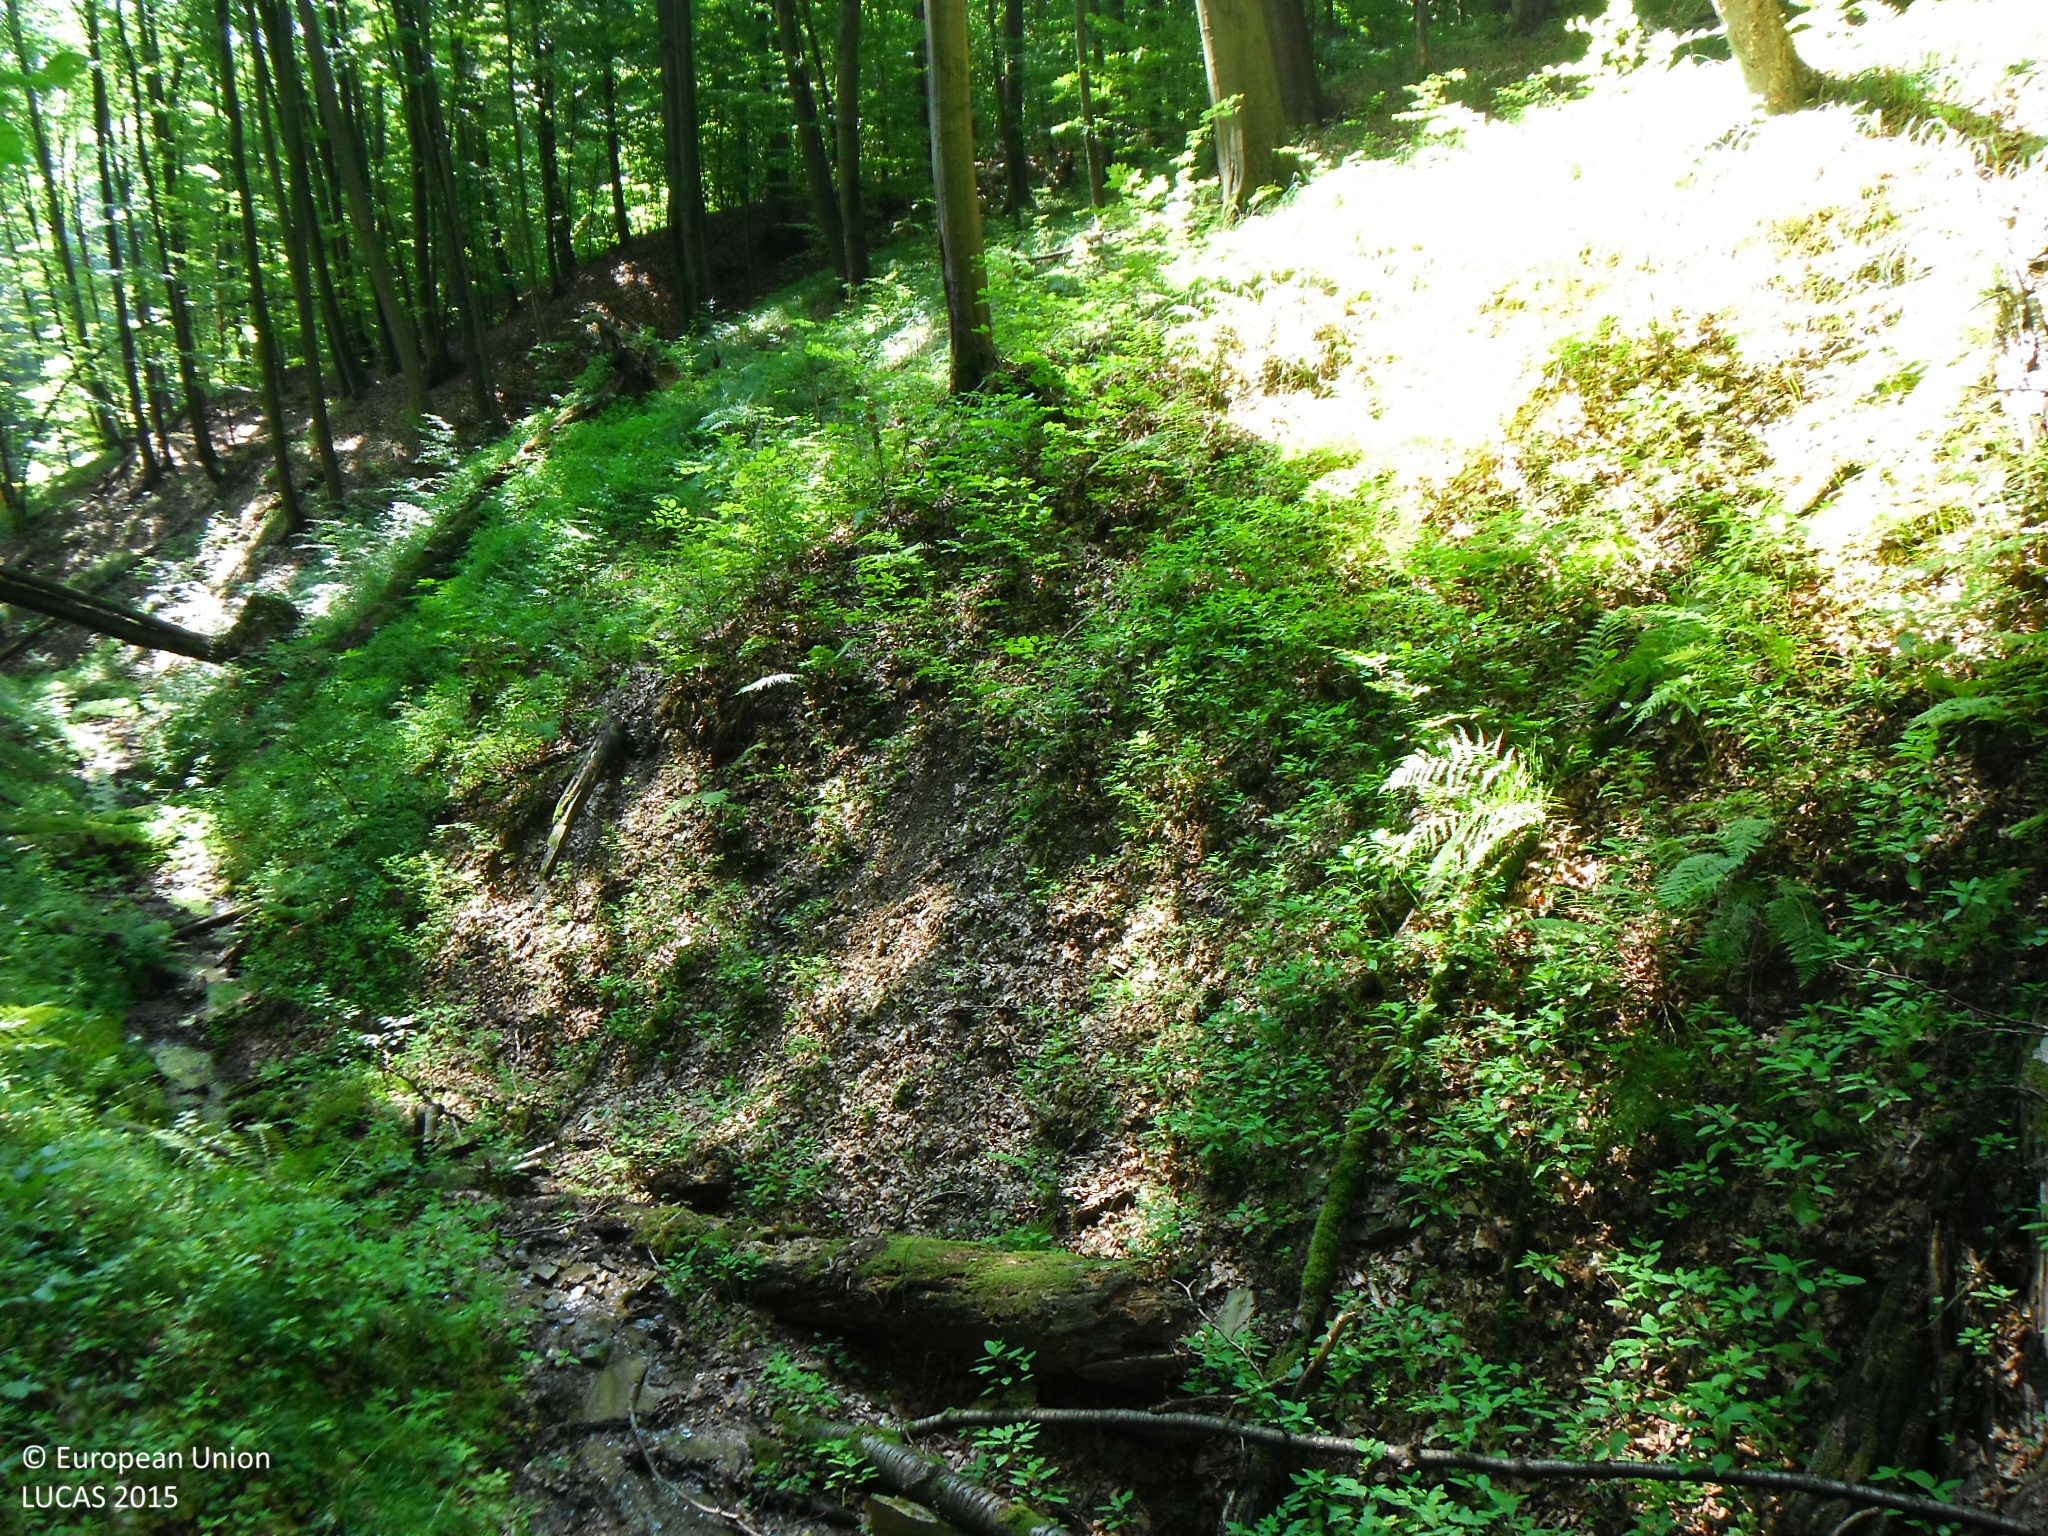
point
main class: Woodland
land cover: Broadleaved woodland
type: beech forest
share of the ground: > 75 %
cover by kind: broadleaved forest trees 90 %, herbaceous plants 10 %
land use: Forestry
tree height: > 5 m
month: July
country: SK
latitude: 49.2612
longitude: 21.4395
